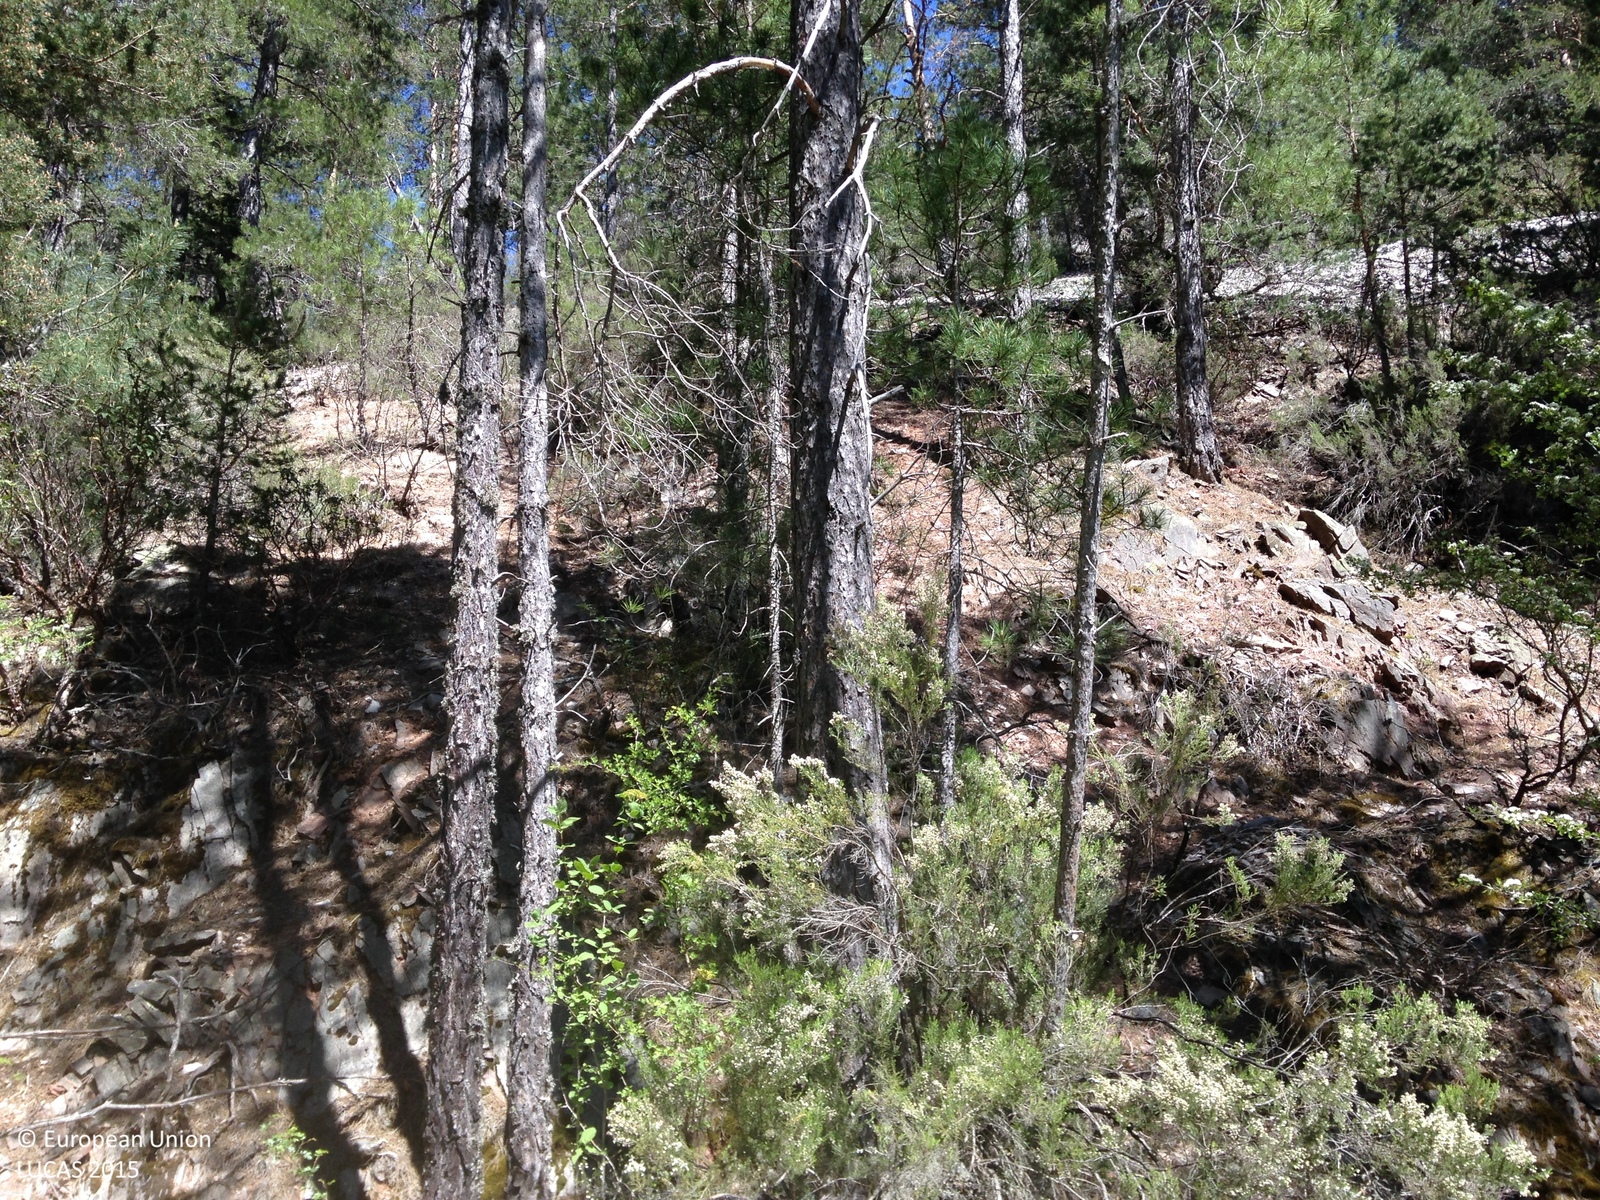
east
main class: Woodland
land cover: Pine dominated coniferous woodland
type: coniferous forest of the mediterranean region
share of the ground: > 75 %
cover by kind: coniferous forest trees 50 %, shrubs 20 %, herbaceous plants 20 %, consolidated bare surface 10 %
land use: Semi-natural and natural areas not in use
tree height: > 5 m
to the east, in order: Pine dominated coniferous woodland; Rock outcrops; Pine dominated mixed woodland
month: May
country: ES
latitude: 40.5680
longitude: -2.0092
